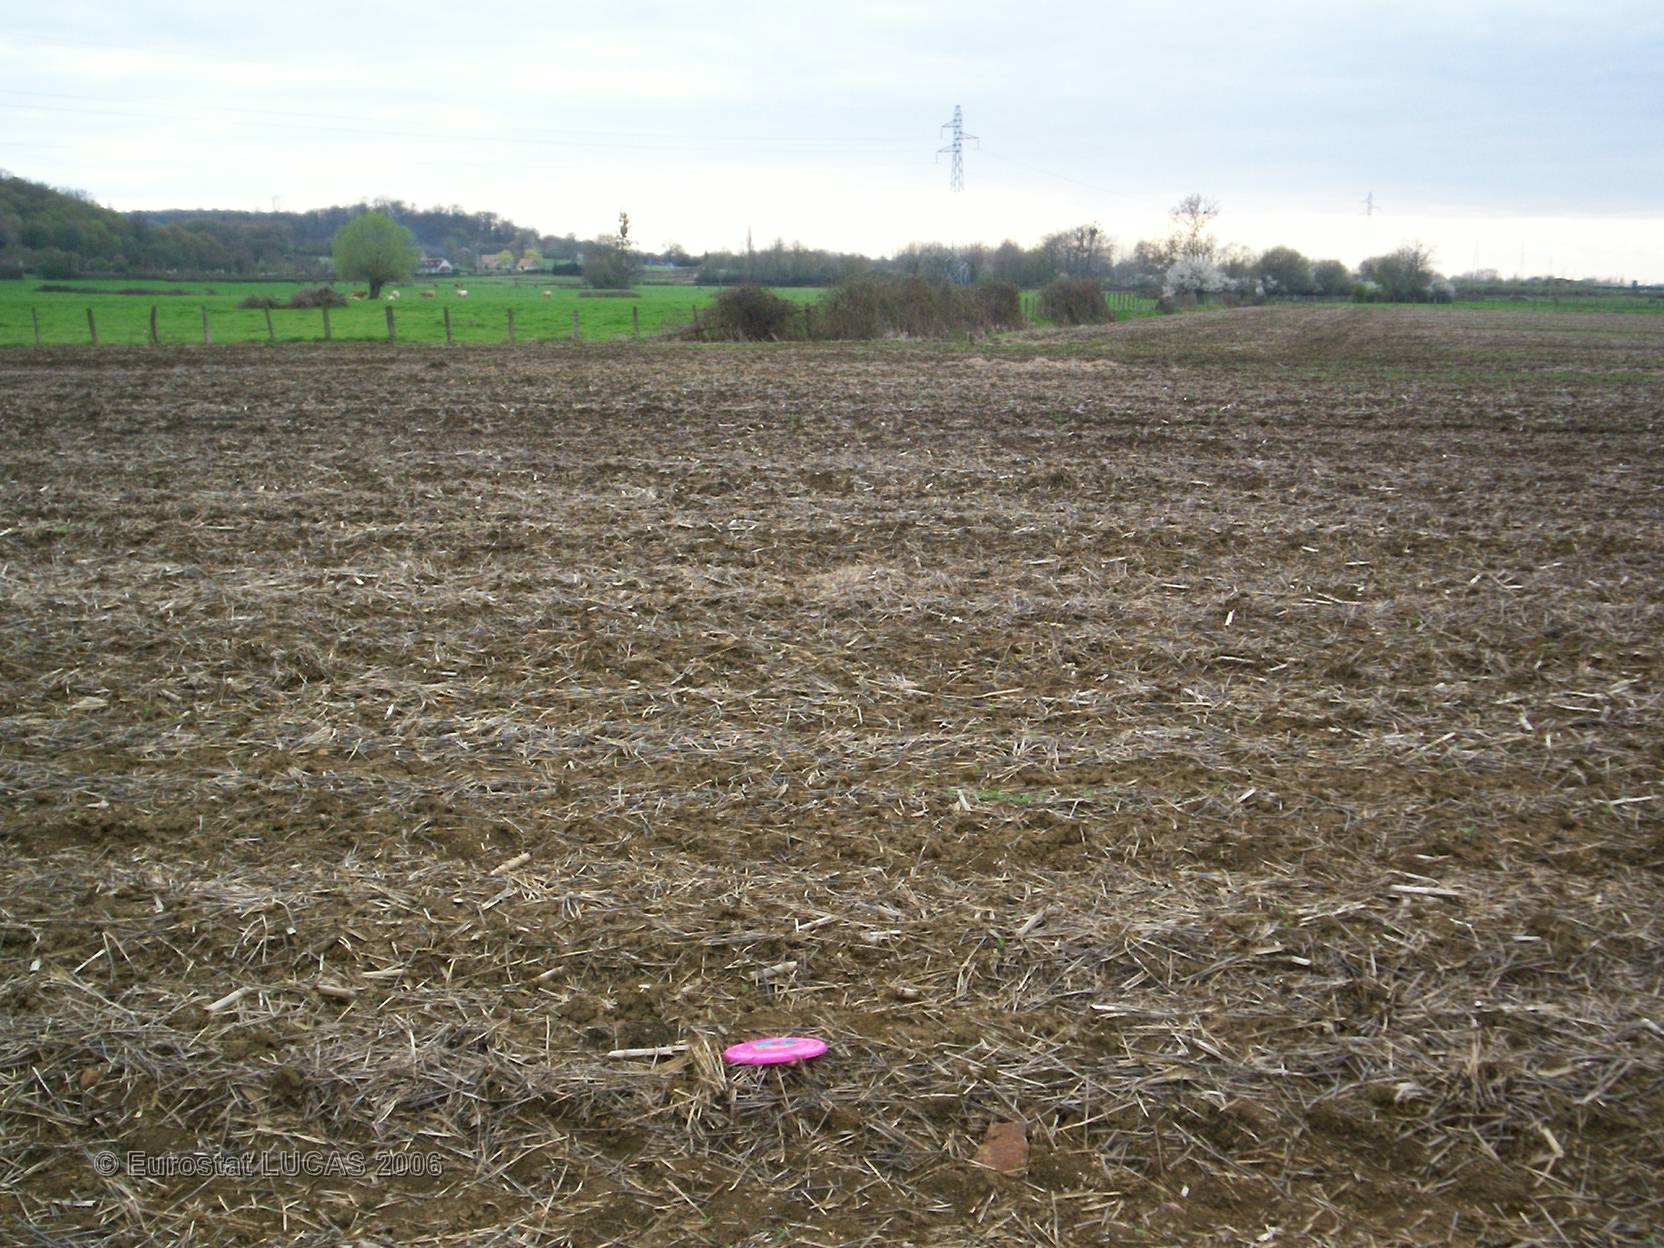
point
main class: Cropland
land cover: Maize
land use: Agriculture (excluding fallow land and kitchen gardens)
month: May
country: FR
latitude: 48.1984
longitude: 0.3550
